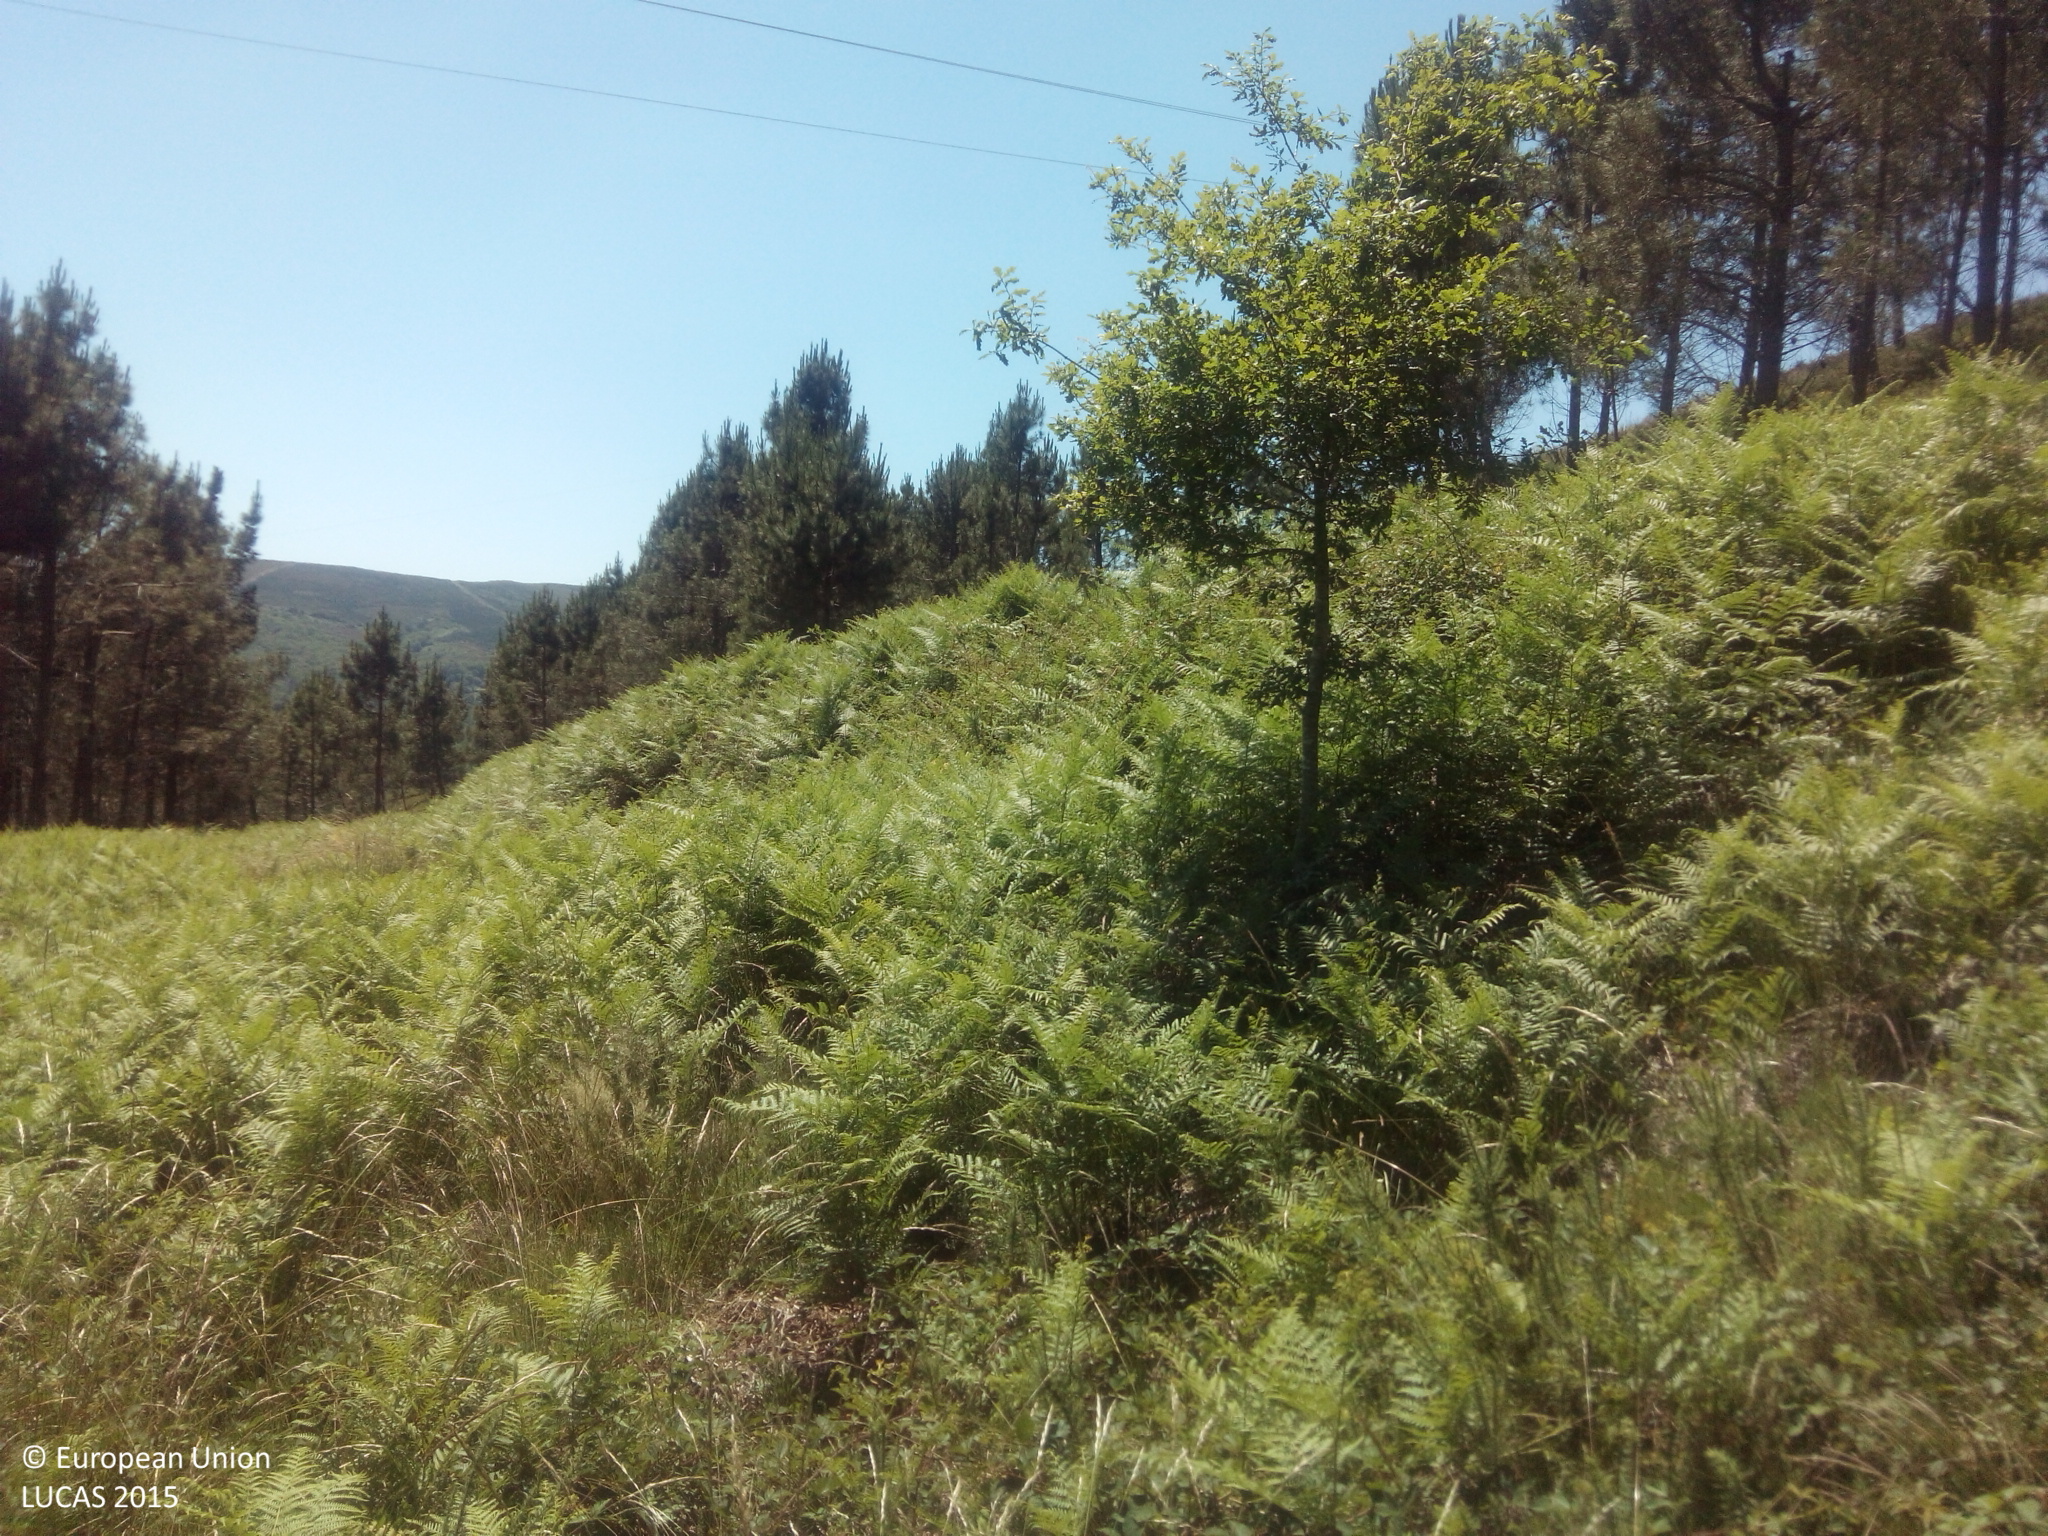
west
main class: Woodland
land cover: Pine dominated coniferous woodland
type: hemiboreal forest and nemoral coniferous forest and mixed broadleaved-coniferous forest
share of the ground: > 75 %
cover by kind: coniferous forest trees 60 %, shrubs 25 %, herbaceous plants 15 %
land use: Forestry
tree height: > 5 m
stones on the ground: < 10 %
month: June
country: ES
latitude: 42.4663
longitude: -8.2980
